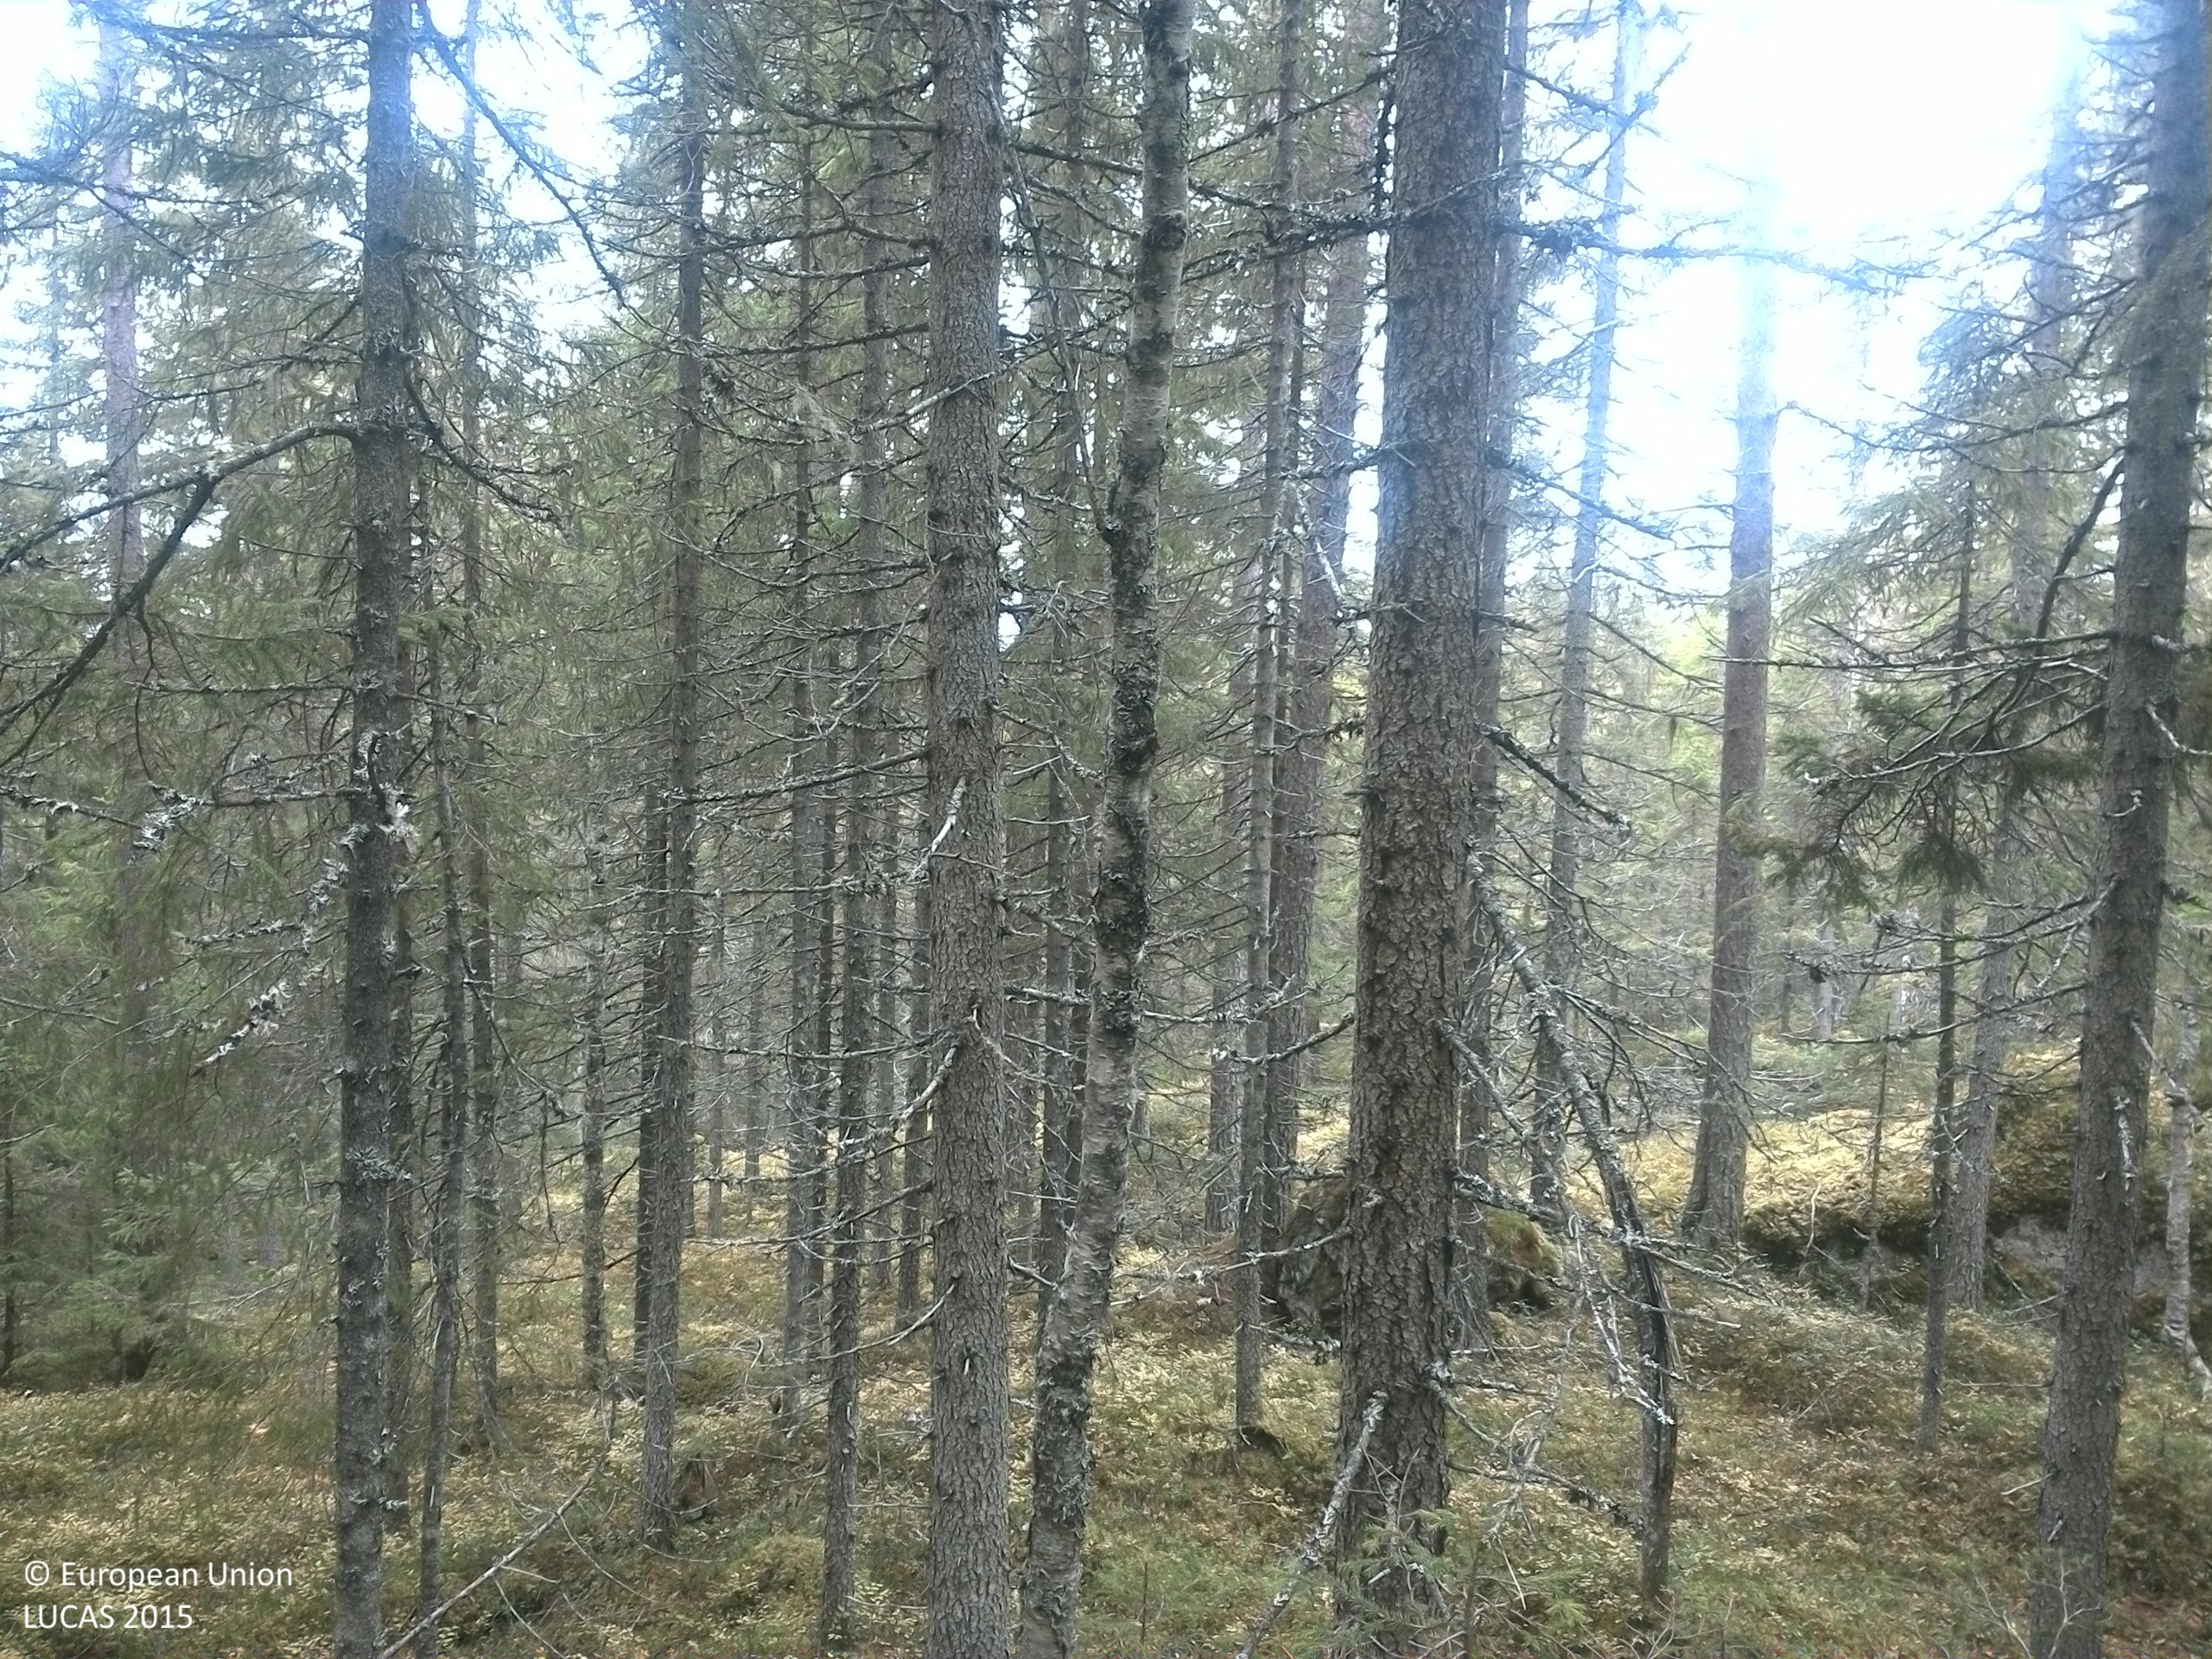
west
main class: Woodland
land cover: Spruce dominated coniferous woodland
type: boreal forest
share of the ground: 50 - 75 %
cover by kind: coniferous forest trees 65 %, shrubs 20 %, lichens and mosses 15 %
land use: Forestry
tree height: > 5 m
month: October
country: SE
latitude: 64.3424
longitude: 14.8375
